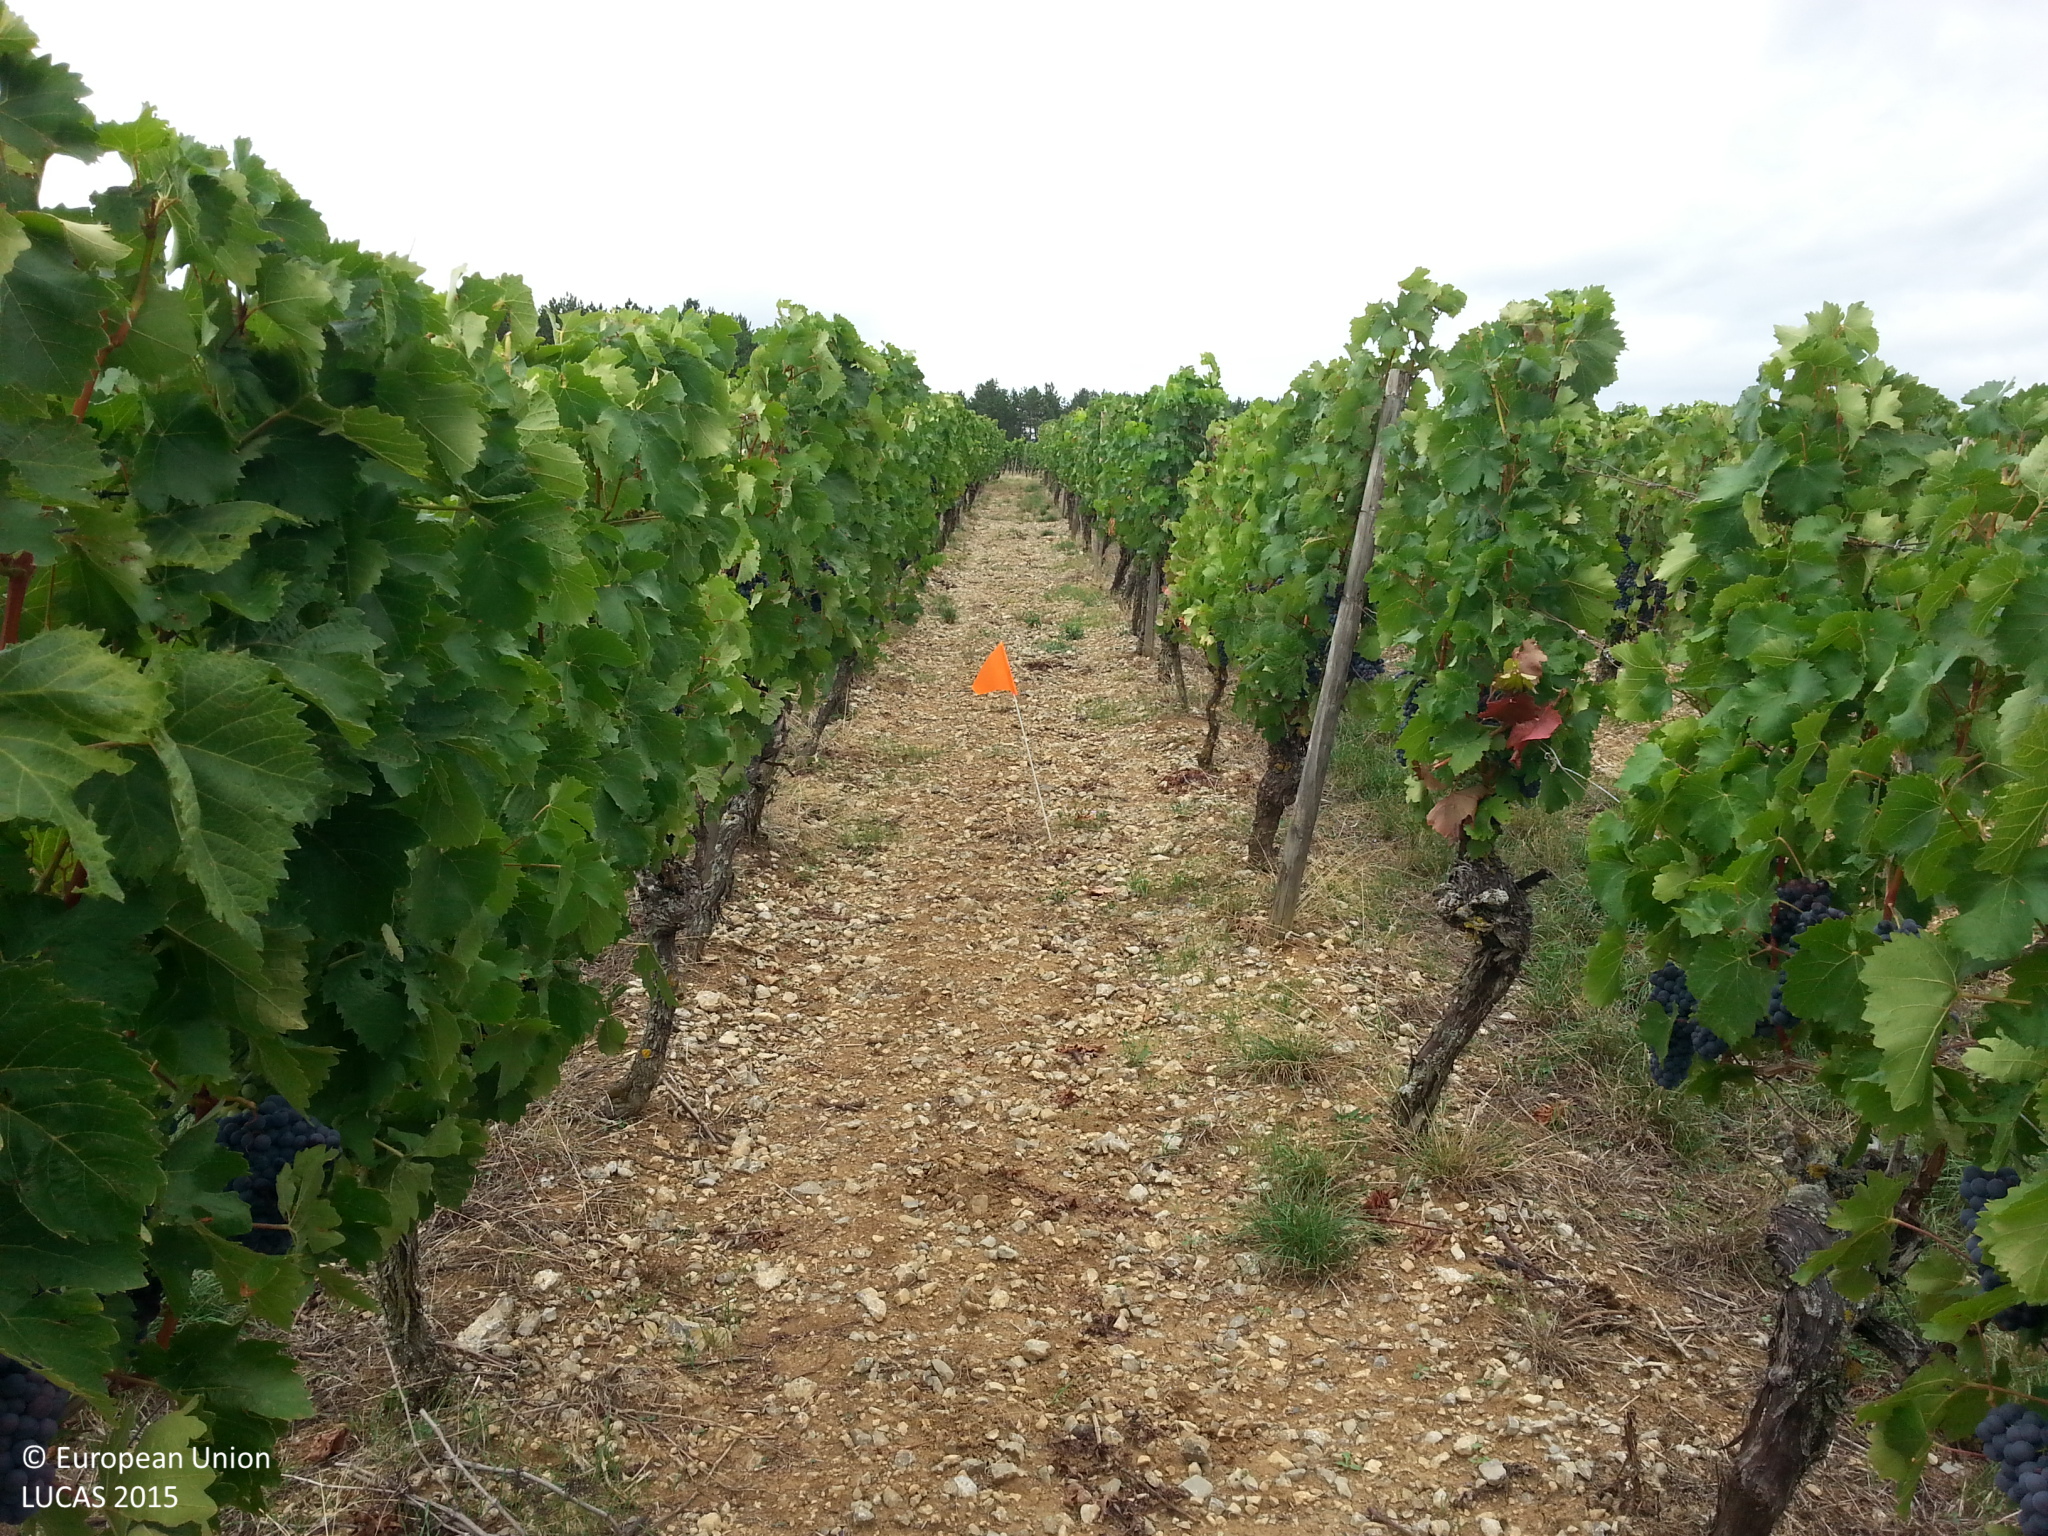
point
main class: Cropland
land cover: Vineyards
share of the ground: 50 - 75 %
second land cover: Spontaneously vegetated surfaces
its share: 10 - 25 %
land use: Agriculture (excluding fallow land and kitchen gardens)
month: September
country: DE
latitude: 49.6080
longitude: 9.5988
